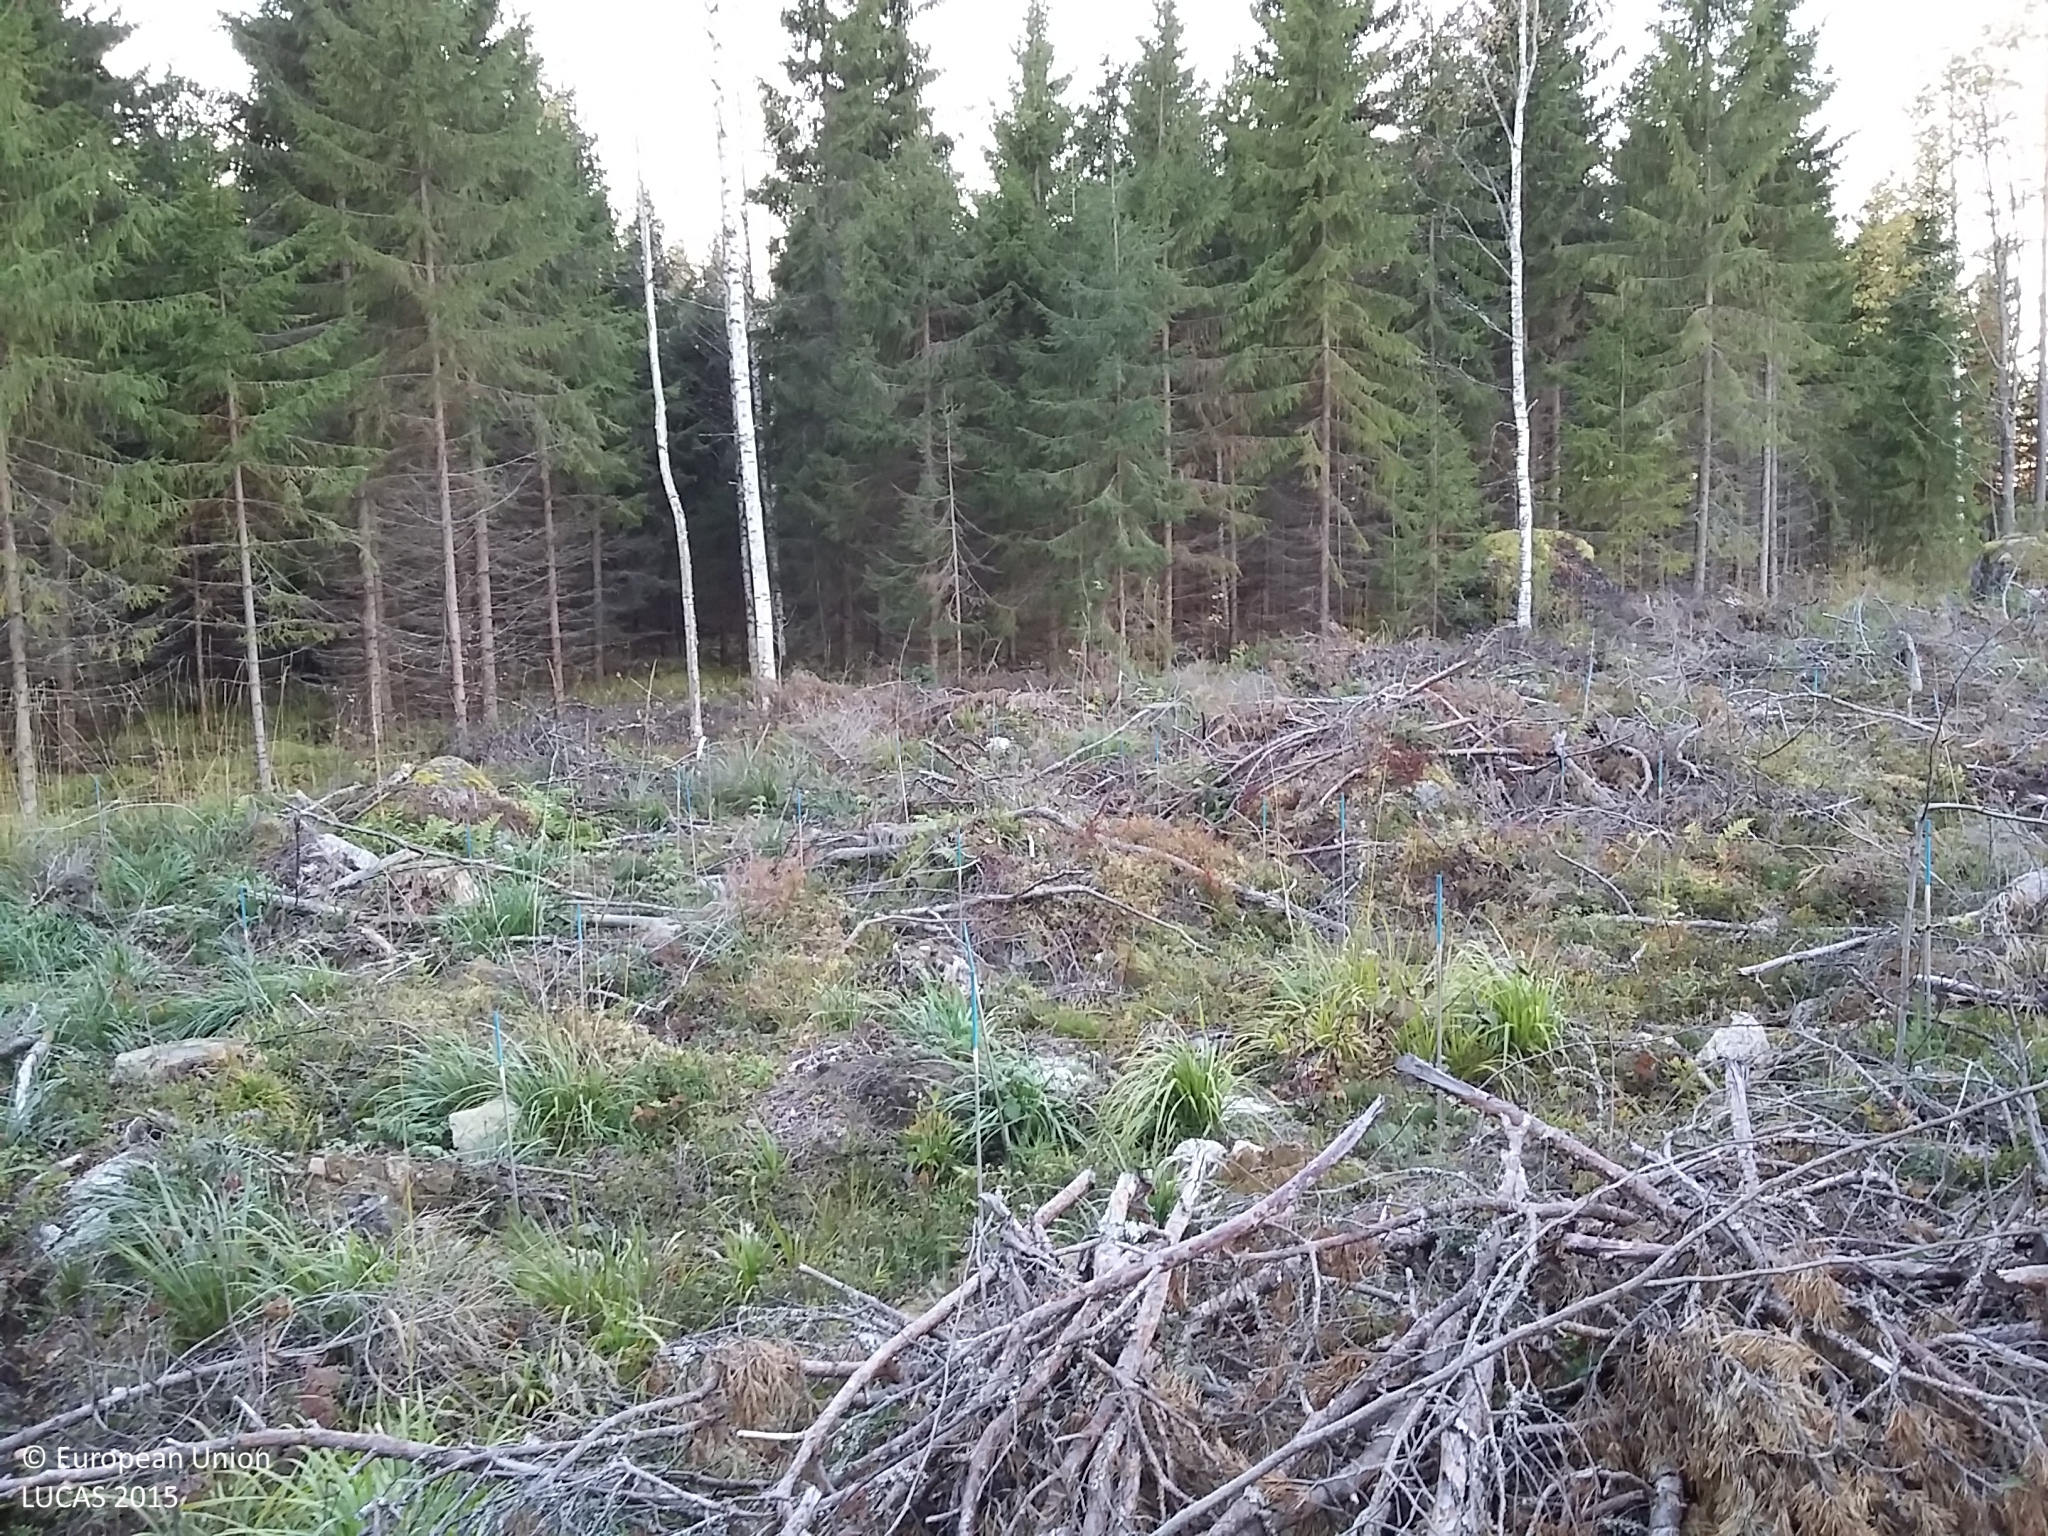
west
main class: Grassland
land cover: Grassland with sparse tree/shrub cover
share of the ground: 10 - 25 %
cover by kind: lichens and mosses 35 %, unconsolidated bare surface 15 %, herbaceous plants 10 %, coniferous forest trees 5 %, shrubs 5 %, consolidated bare surface 5 %
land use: Forestry
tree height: < 5 m
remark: Clear cut
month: October
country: FI
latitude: 62.7154
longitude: 25.9393
